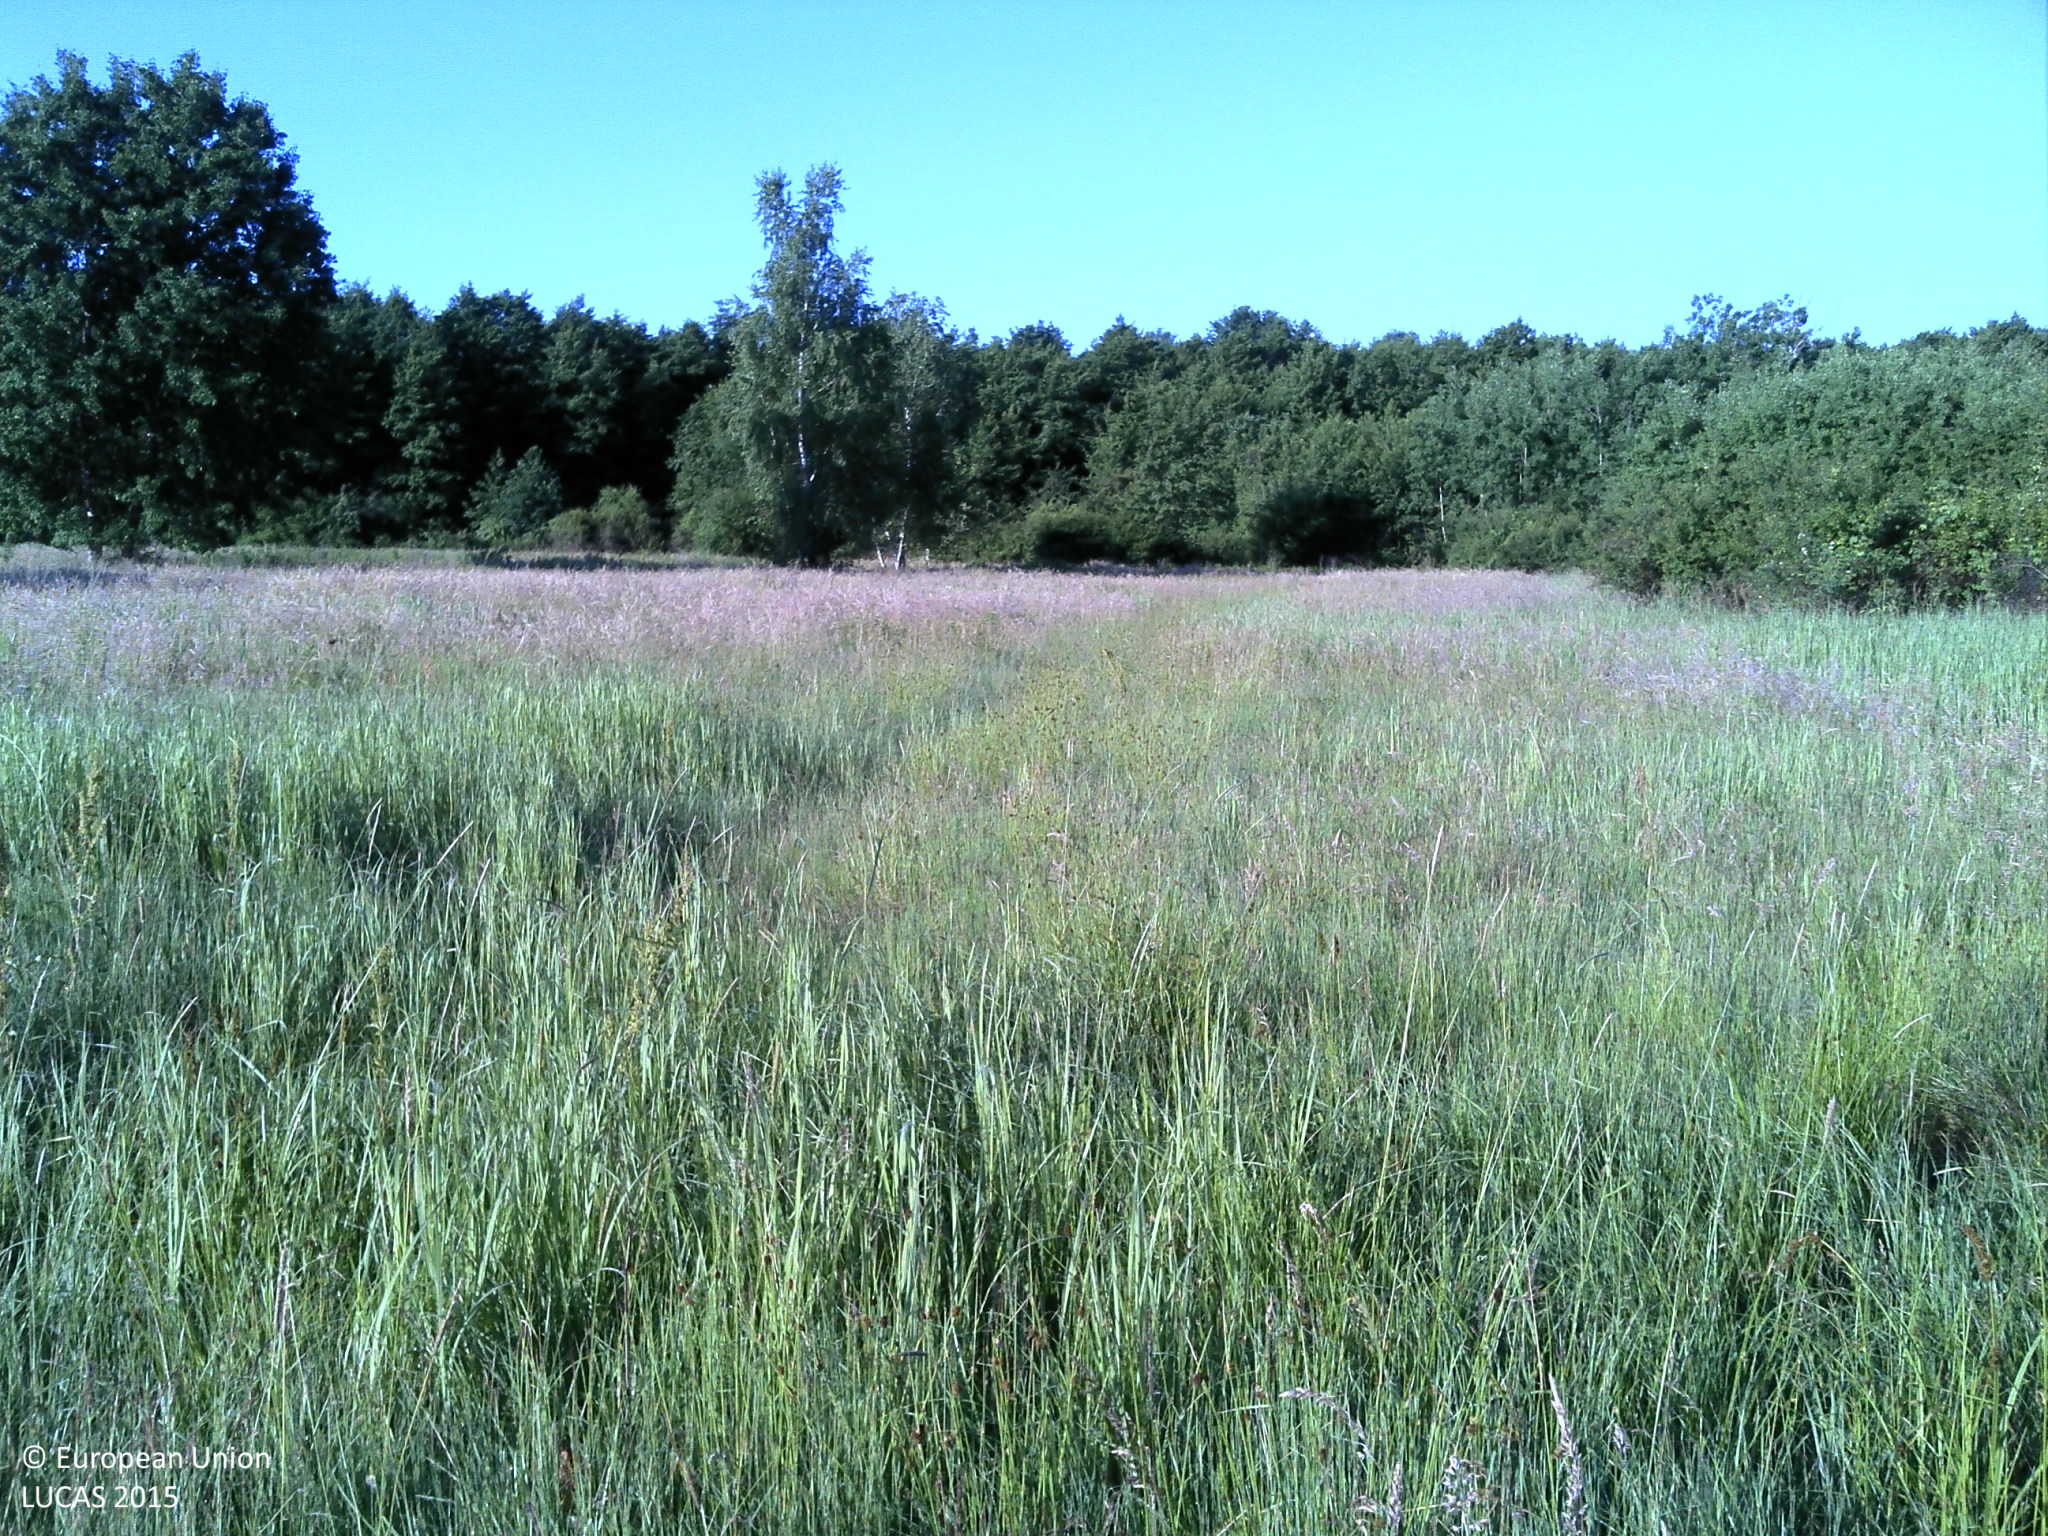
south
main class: Grassland
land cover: Spontaneously vegetated surfaces
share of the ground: > 75 %
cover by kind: herbaceous plants 100 %
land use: Abandoned areas
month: May
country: HR
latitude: 45.5477
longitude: 17.9578
